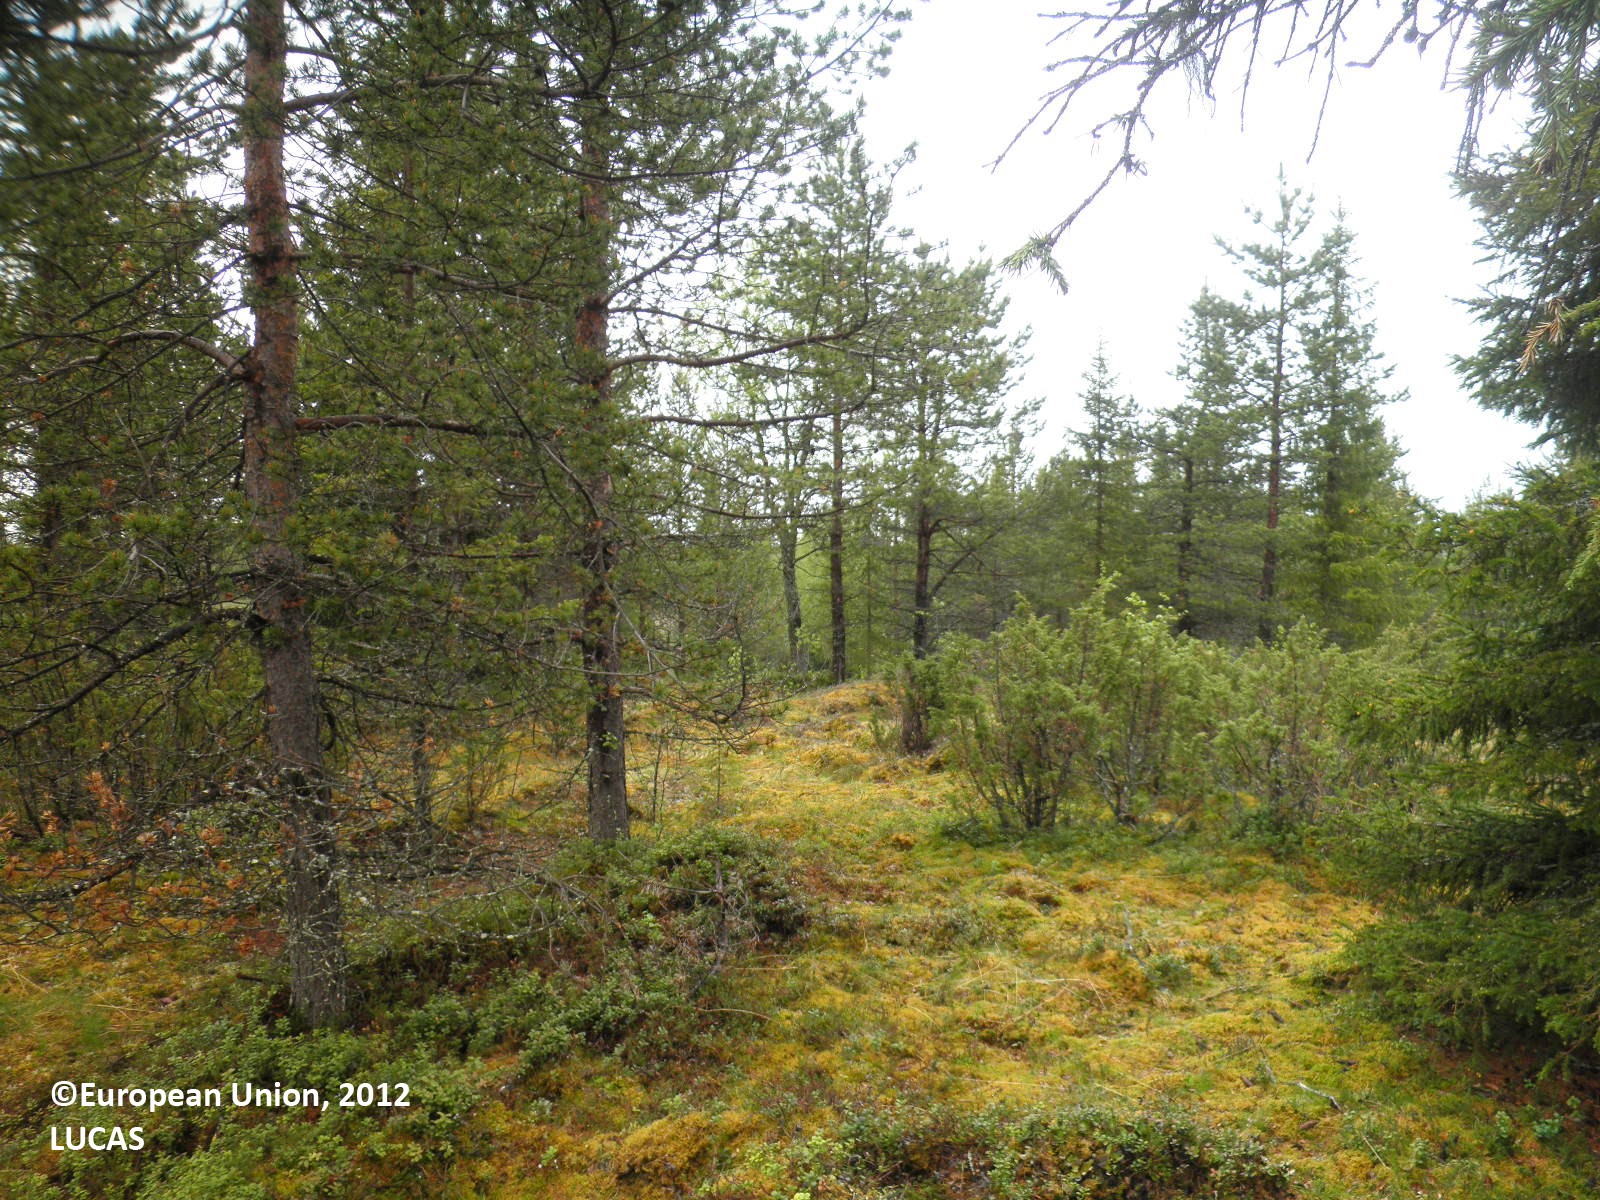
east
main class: Woodland
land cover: Other coniferous woodland
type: boreal forest
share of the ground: 25 - 50 %
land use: Forestry
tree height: > 5 m
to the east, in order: Other coniferous woodland; Ditches and canals; Shrubland with sparse tree cover; Peatbogs
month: June
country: FI
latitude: 68.1028
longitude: 25.6362
